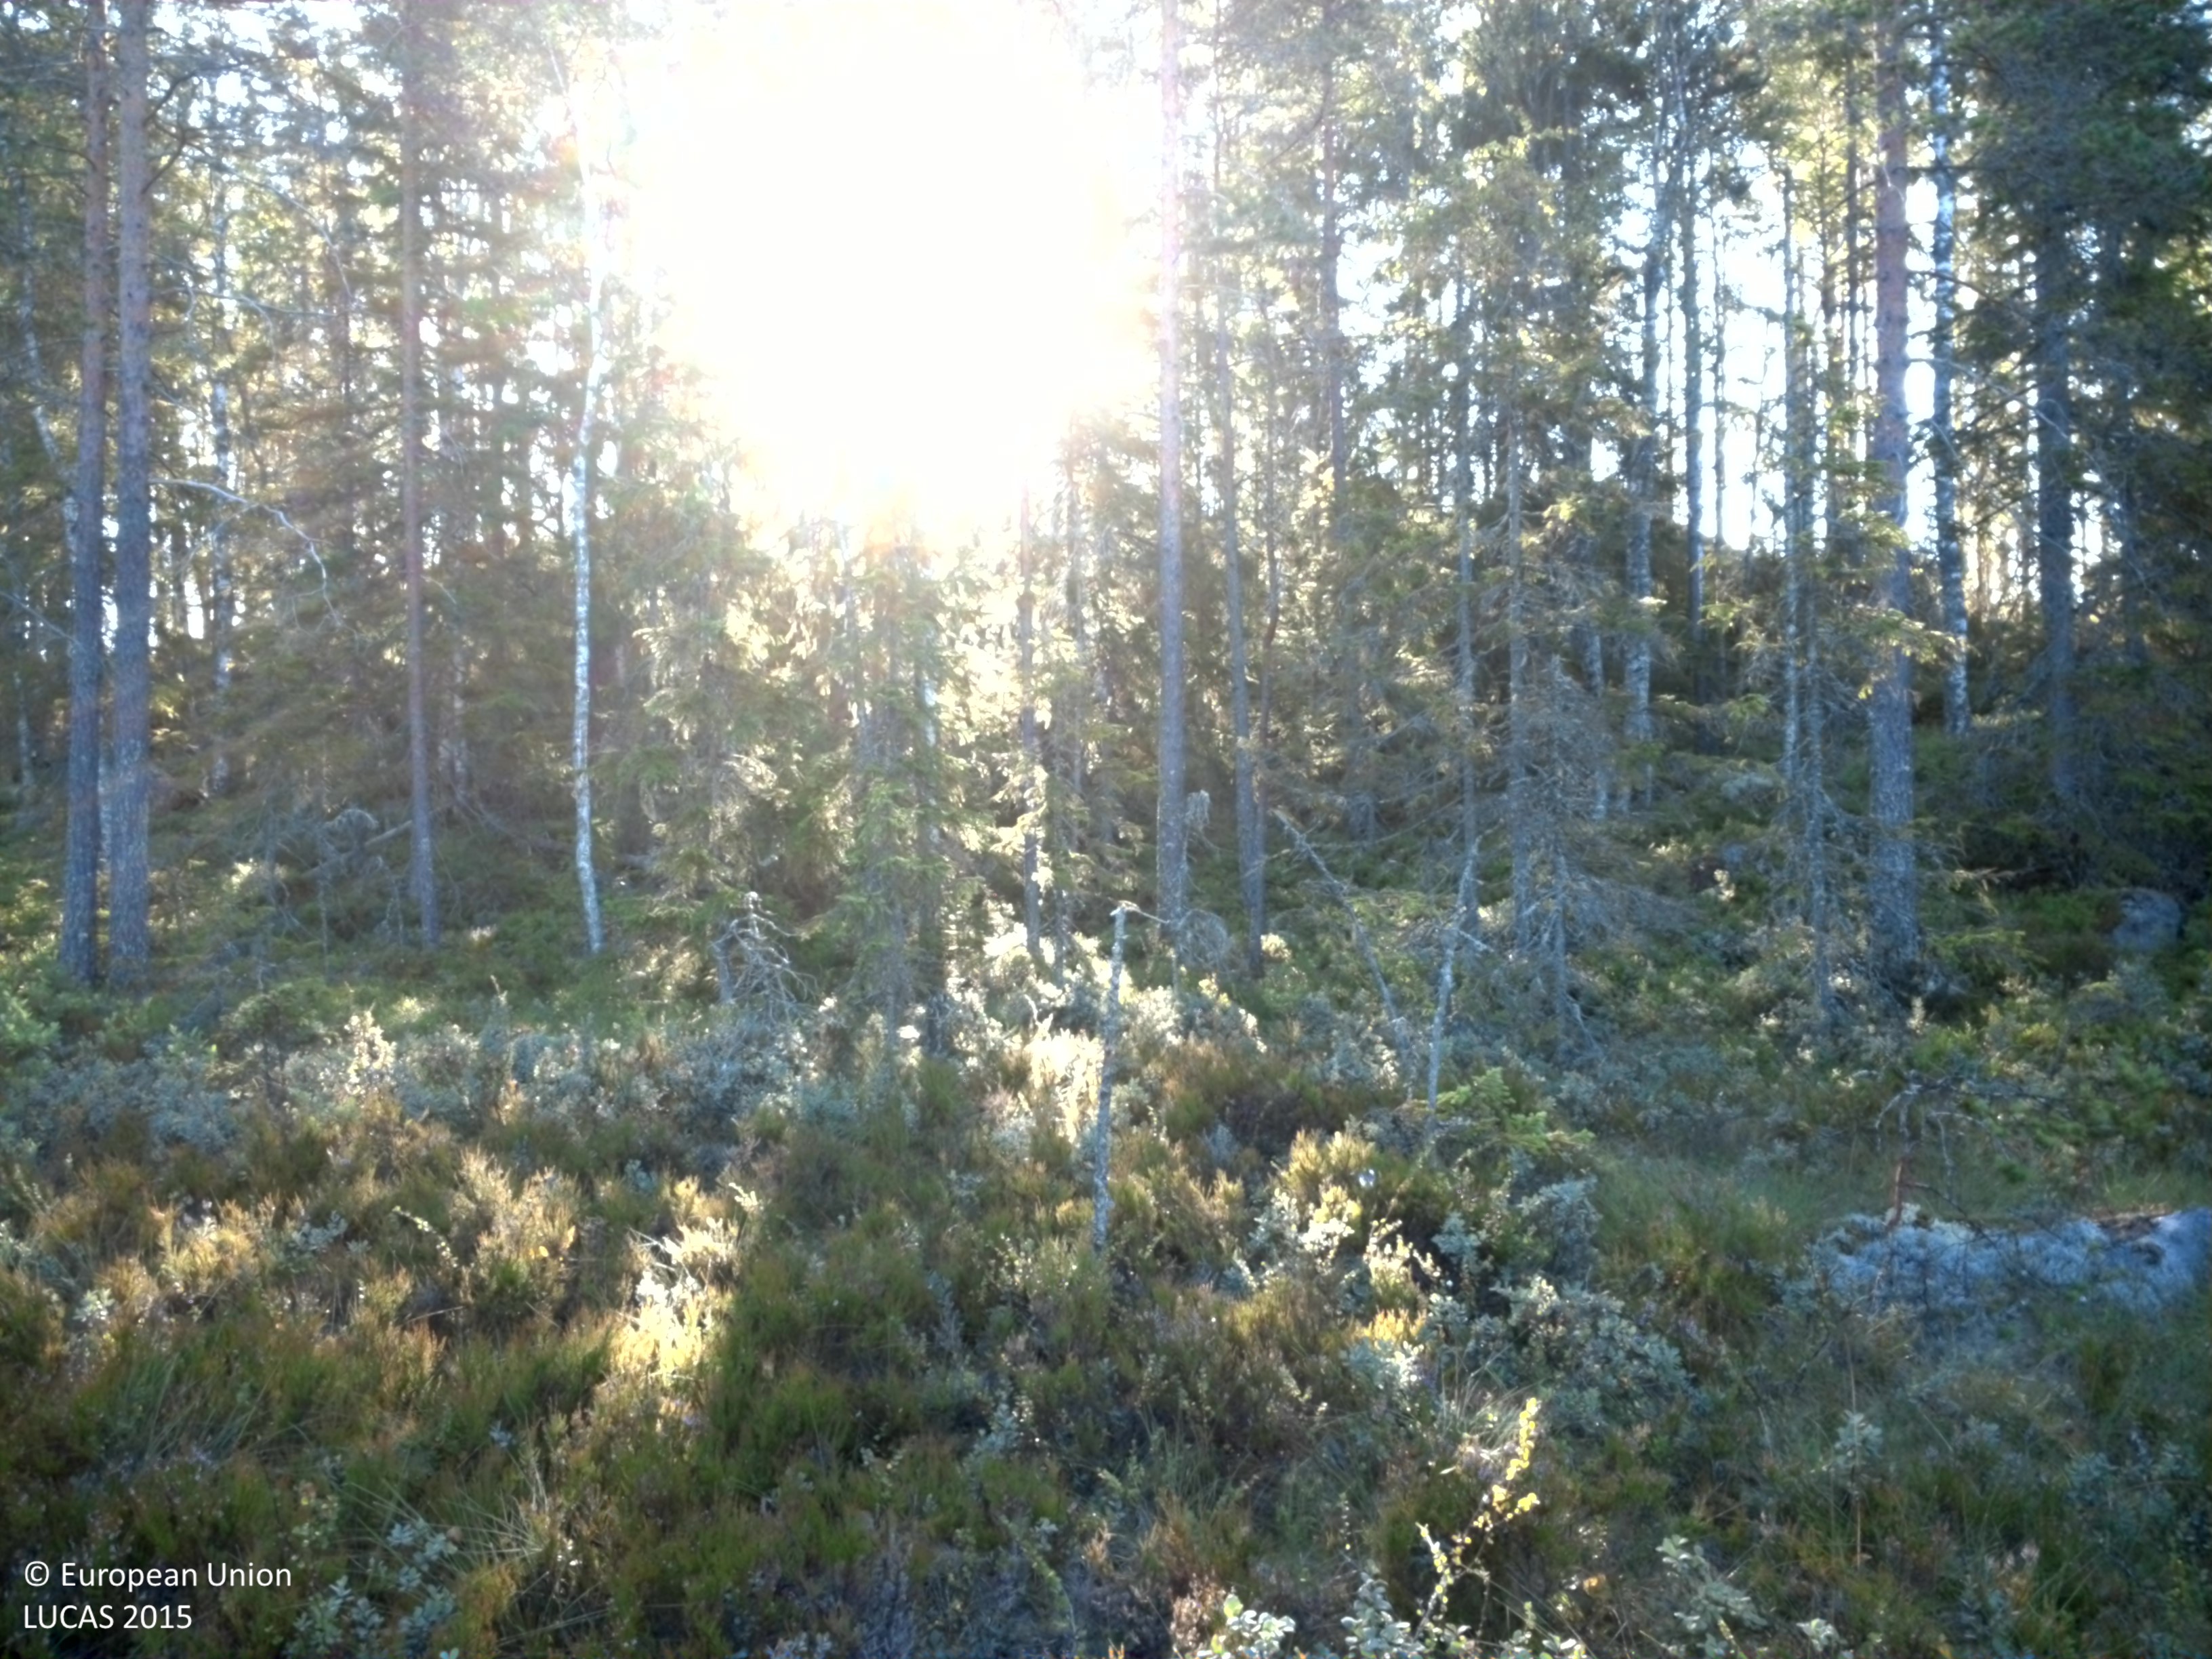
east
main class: Woodland
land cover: Pine dominated coniferous woodland
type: boreal forest
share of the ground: 25 - 50 %
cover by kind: coniferous forest trees 40 %, shrubs 40 %, lichens and mosses 20 %
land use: Semi-natural and natural areas not in use
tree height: > 5 m
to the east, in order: Pine dominated coniferous woodland; Pine dominated mixed woodland; Shrubland with sparse tree cover; Shruby margins; Paved roads, cycling and walking lanes; Shruby margins; Rock outcrops; Spruce dominated mixed woodland
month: August
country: SE
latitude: 59.9031
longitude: 14.1557
